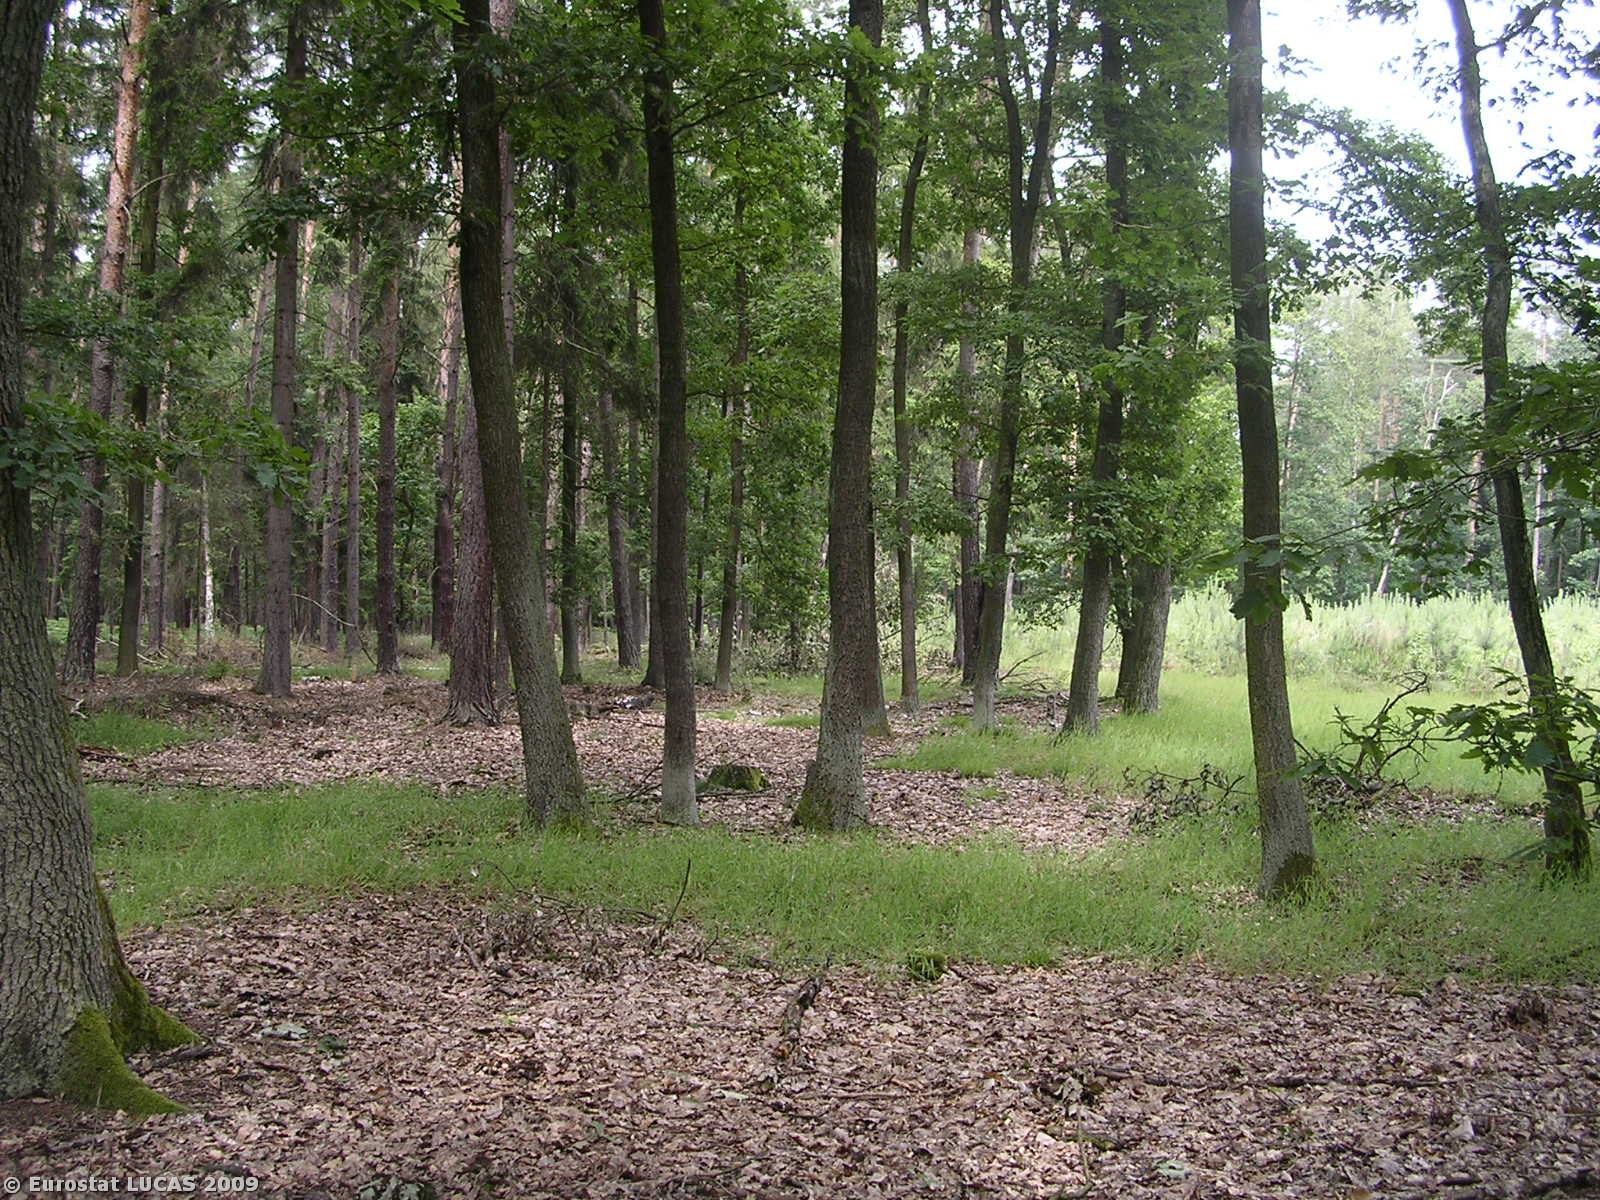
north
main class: Woodland
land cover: Broadleaved woodland
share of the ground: > 75 %
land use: Forestry
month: June
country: CZ
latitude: 50.4768
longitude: 14.8641
